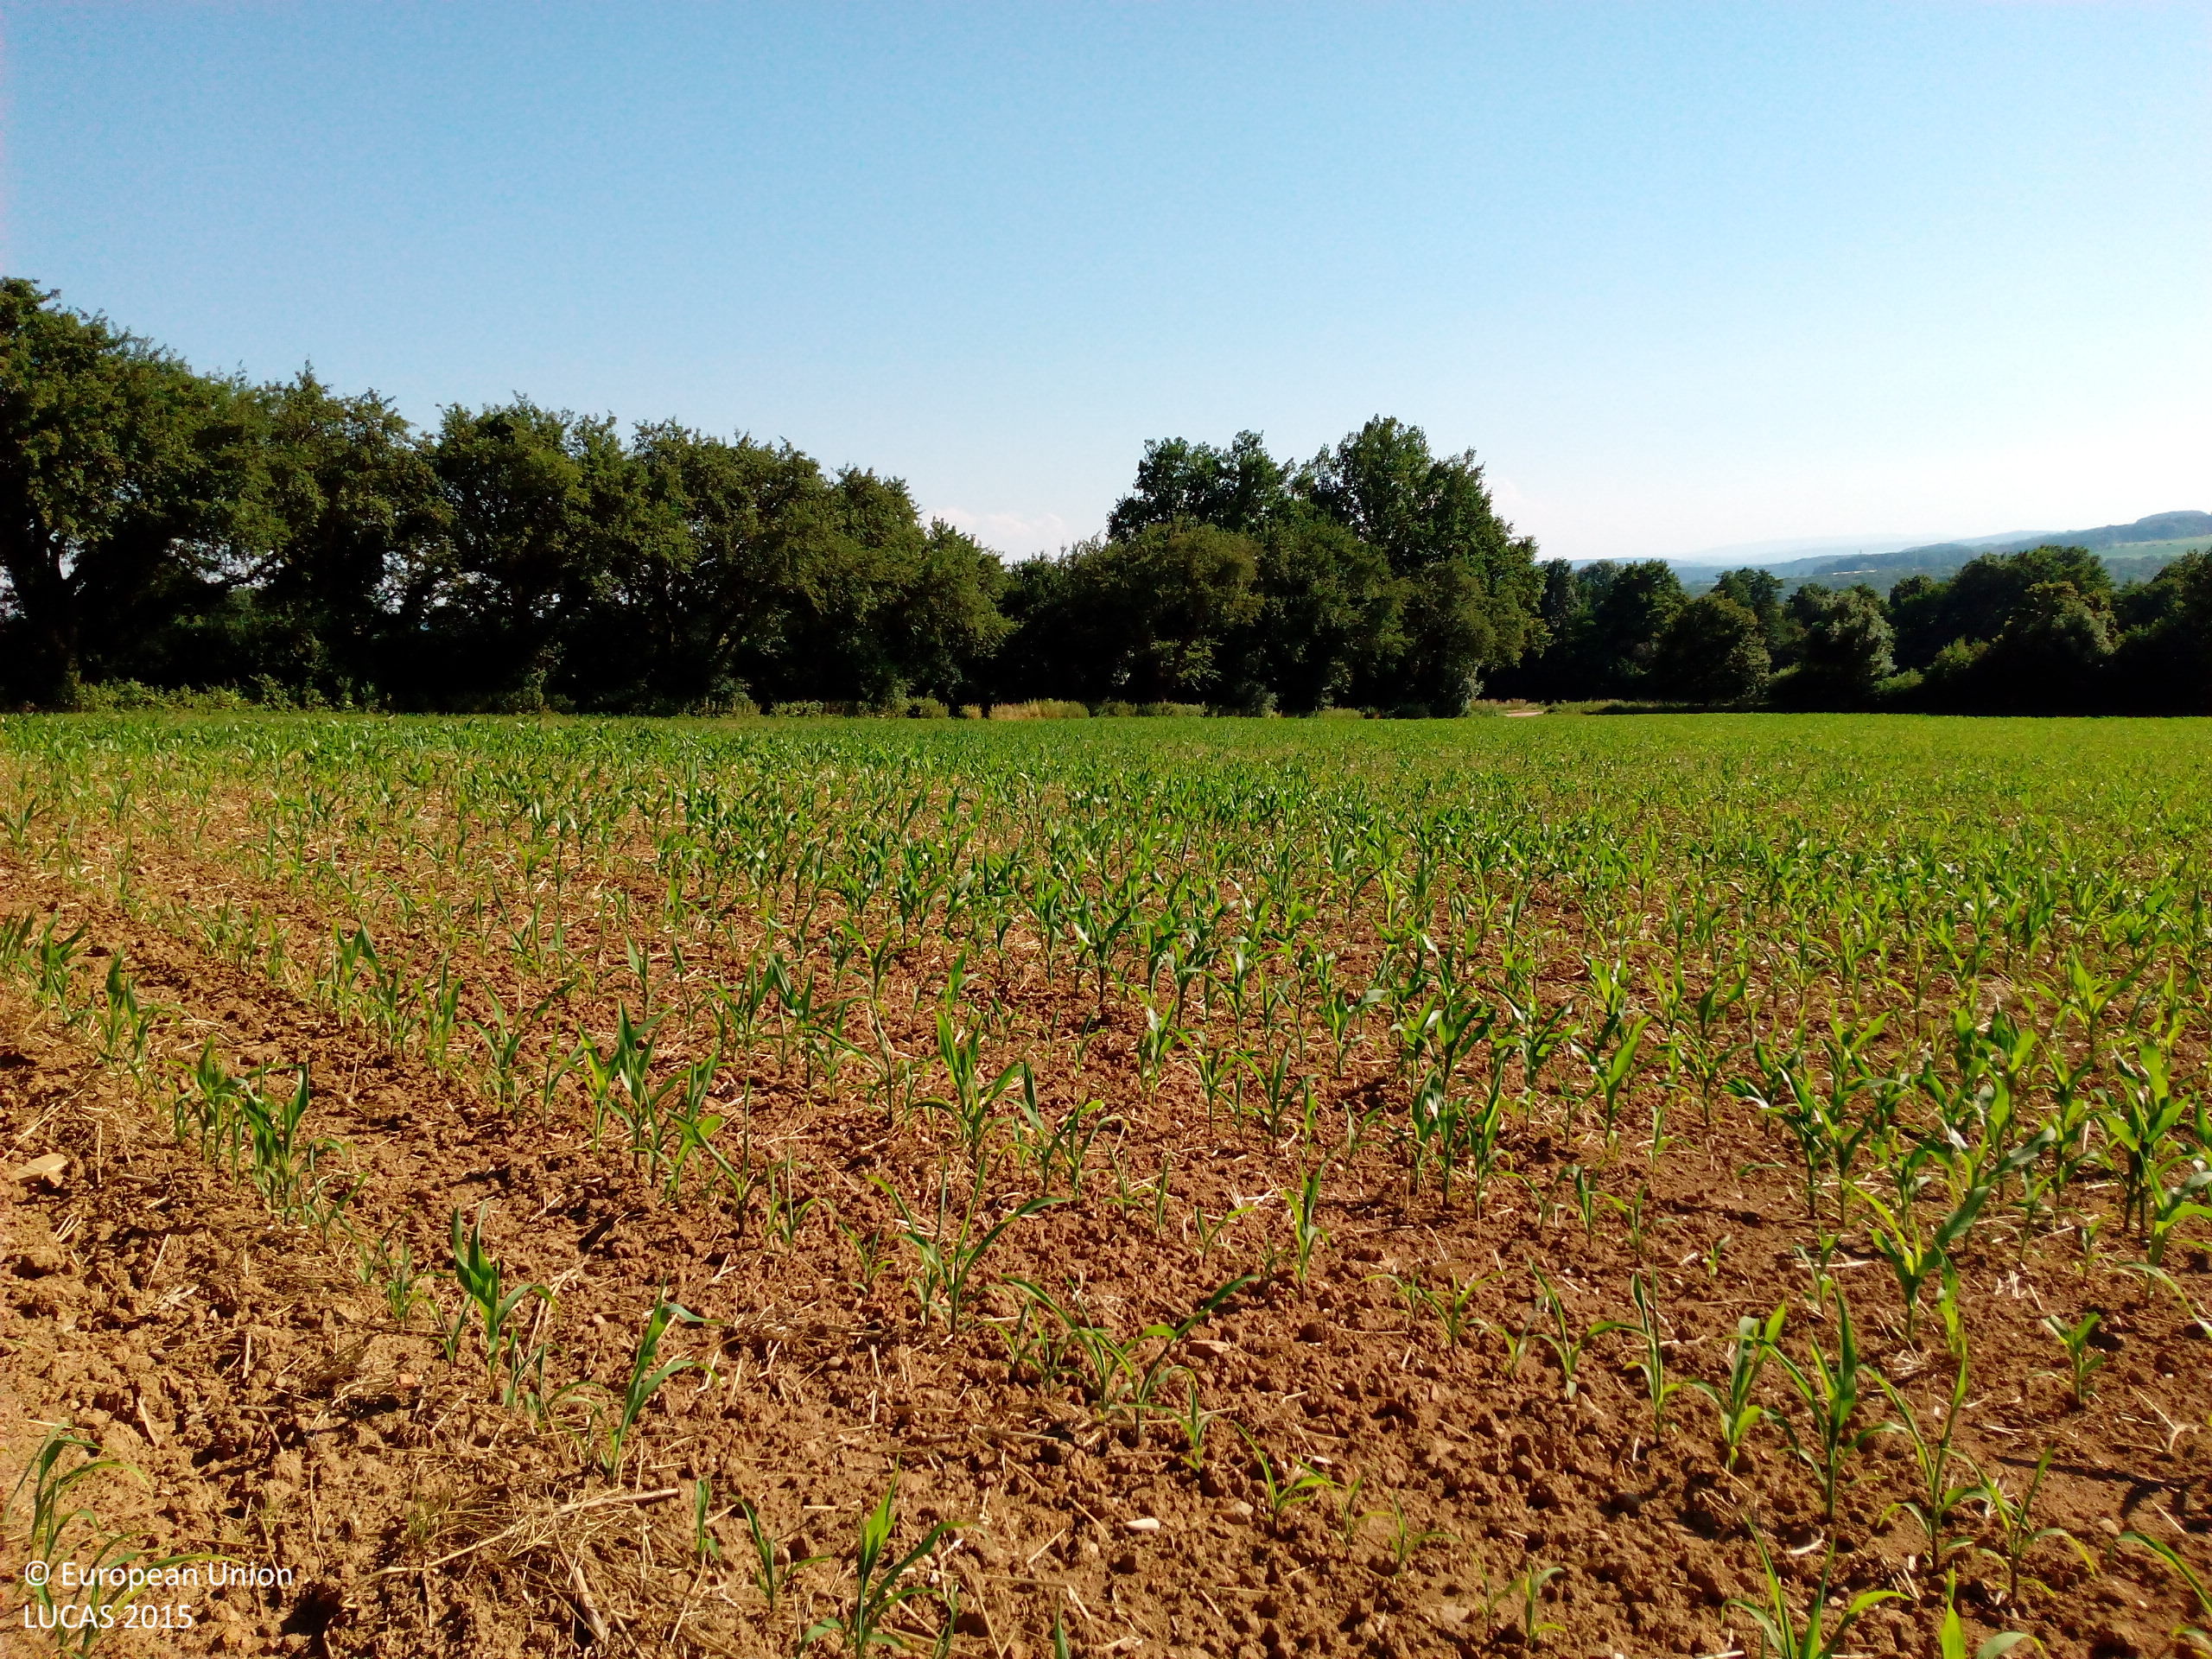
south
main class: Cropland
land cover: Maize
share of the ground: 25 - 50 %
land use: Agriculture (excluding fallow land and kitchen gardens)
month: July
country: DE
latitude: 47.7843
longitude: 8.7329
